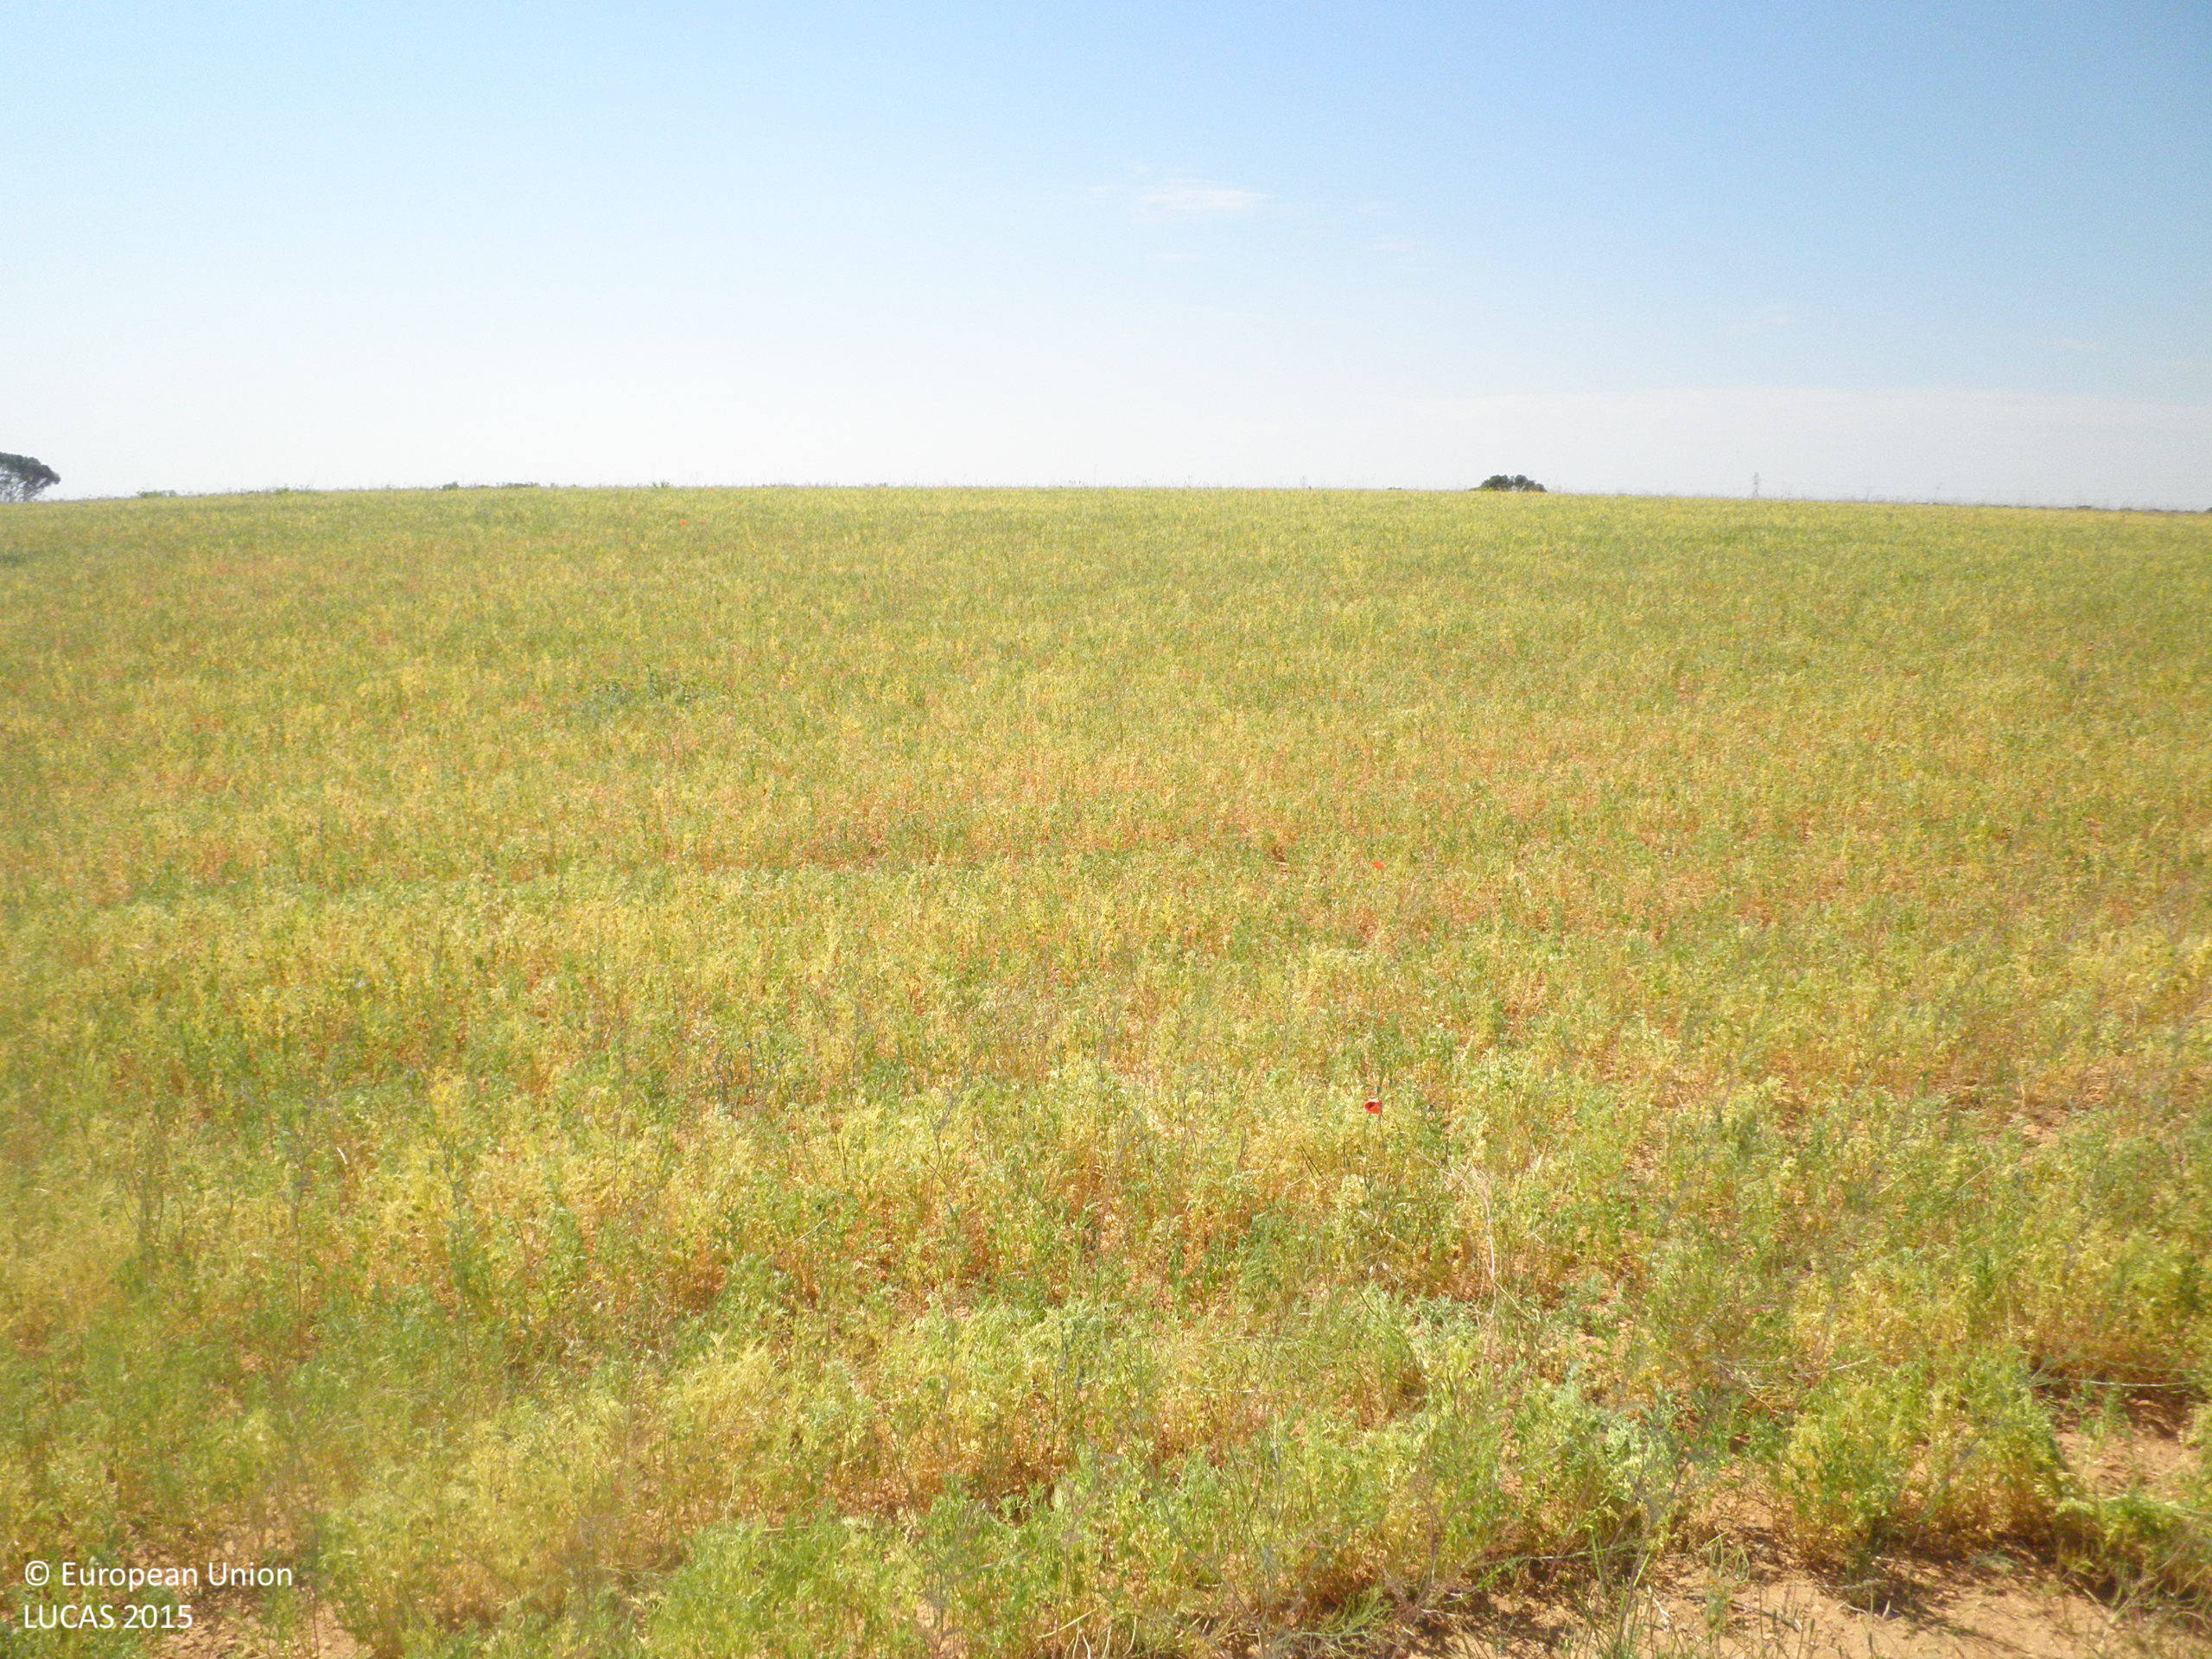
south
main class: Woodland
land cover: Broadleaved woodland
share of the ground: > 75 %
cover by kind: herbaceous plants 60 %, unconsolidated bare surface 25 %, broadleaved forest trees 15 %
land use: Semi-natural and natural areas not in use
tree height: < 5 m
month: June
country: ES
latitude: 39.5145
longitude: -1.8123
